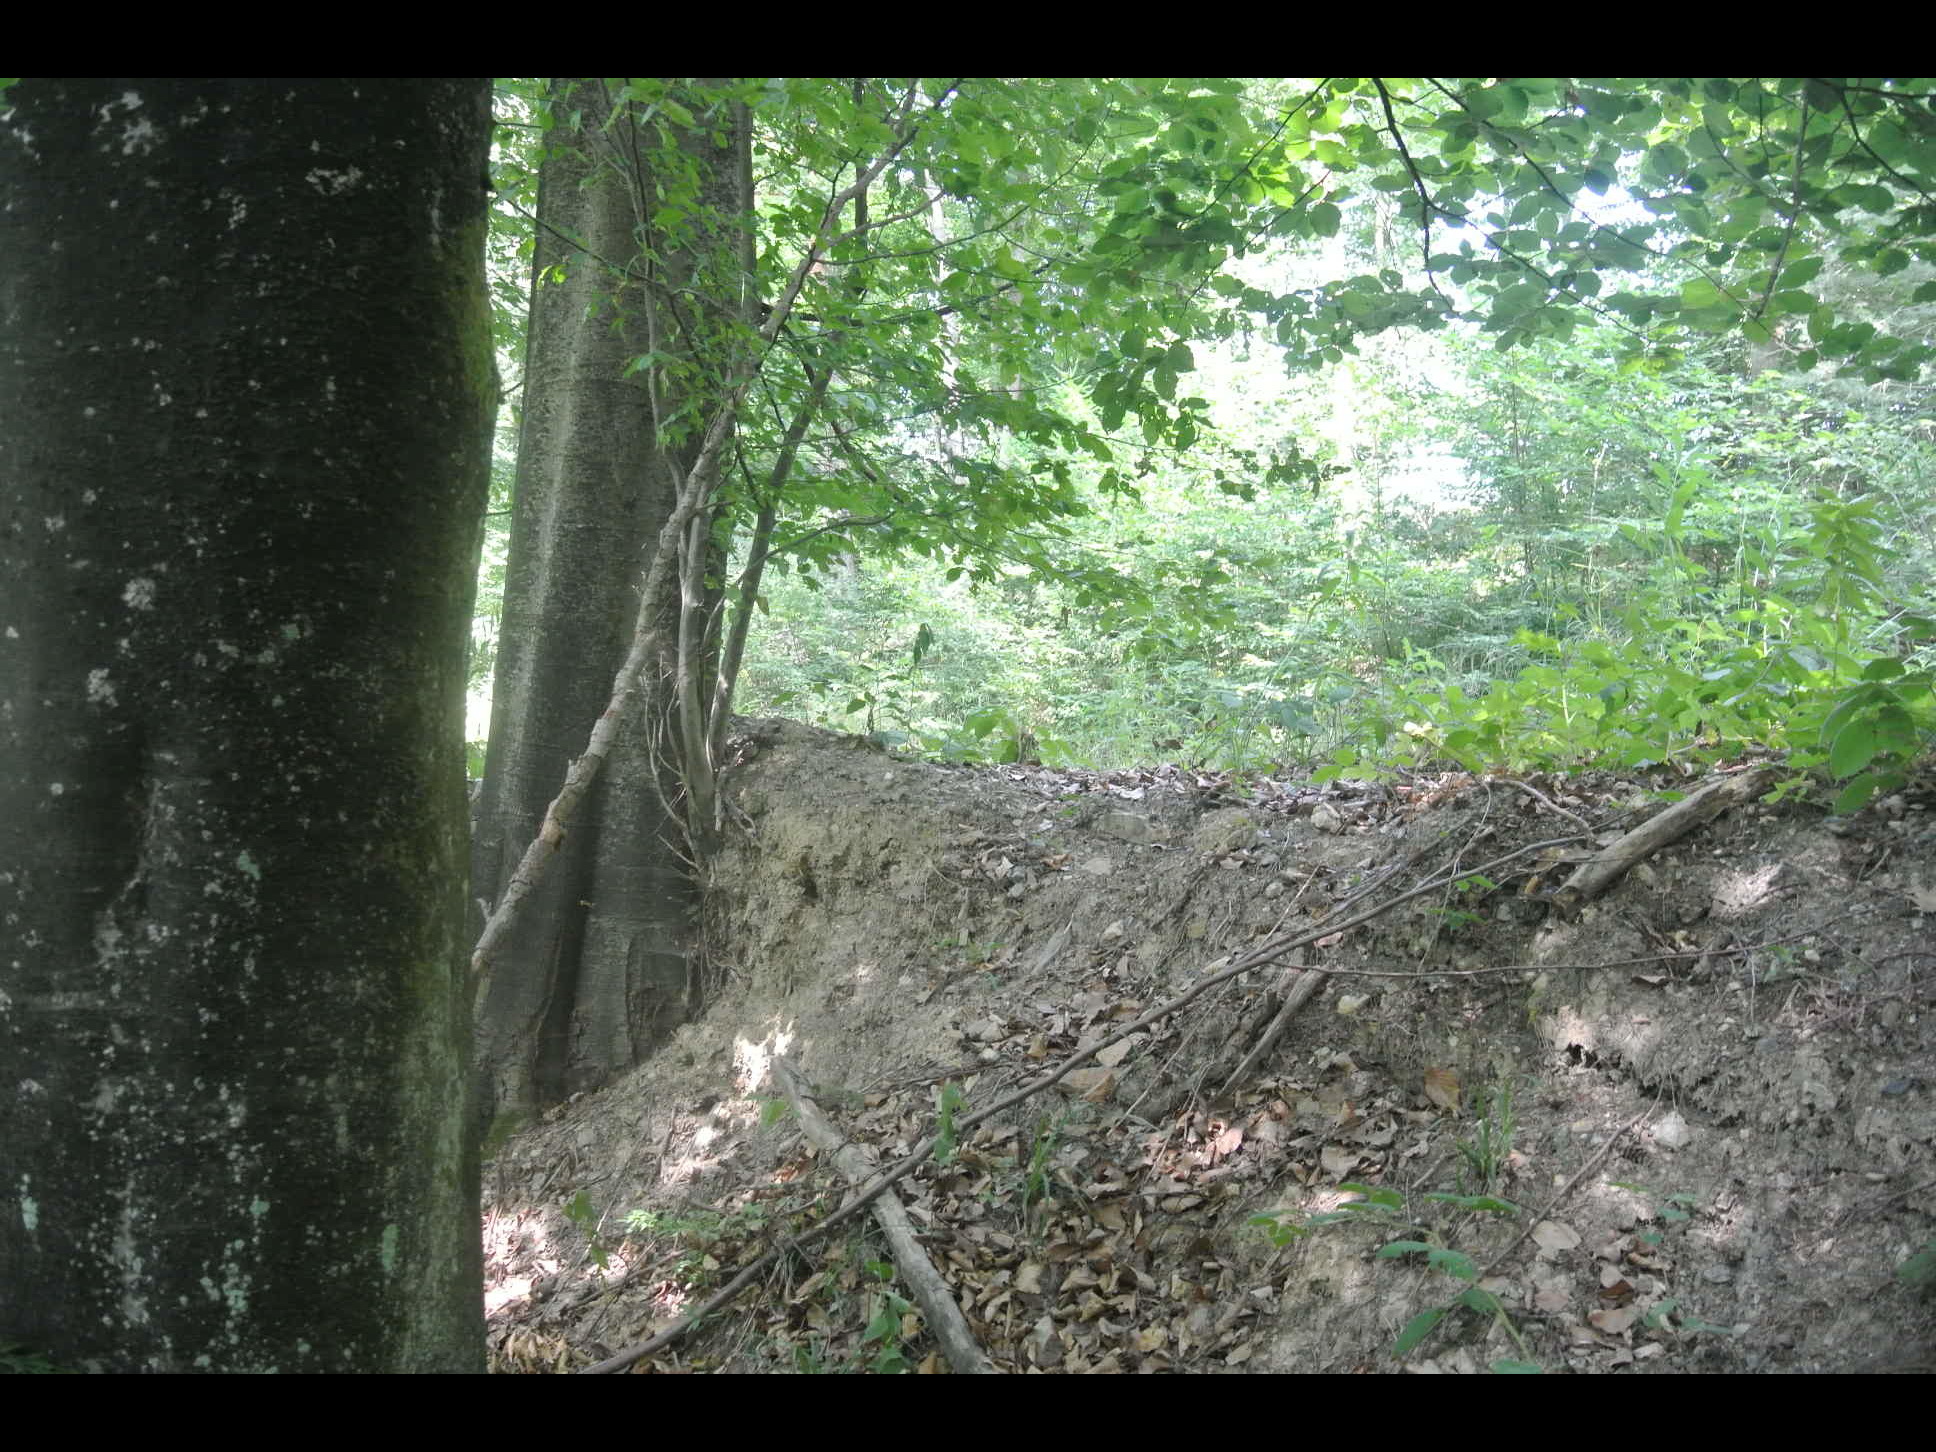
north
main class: Woodland
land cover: Broadleaved woodland
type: beech forest
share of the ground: > 75 %
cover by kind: broadleaved forest trees 95 %, coniferous forest trees 5 %
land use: Forestry
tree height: > 5 m
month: July
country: AT
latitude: 47.4039
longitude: 16.4301
